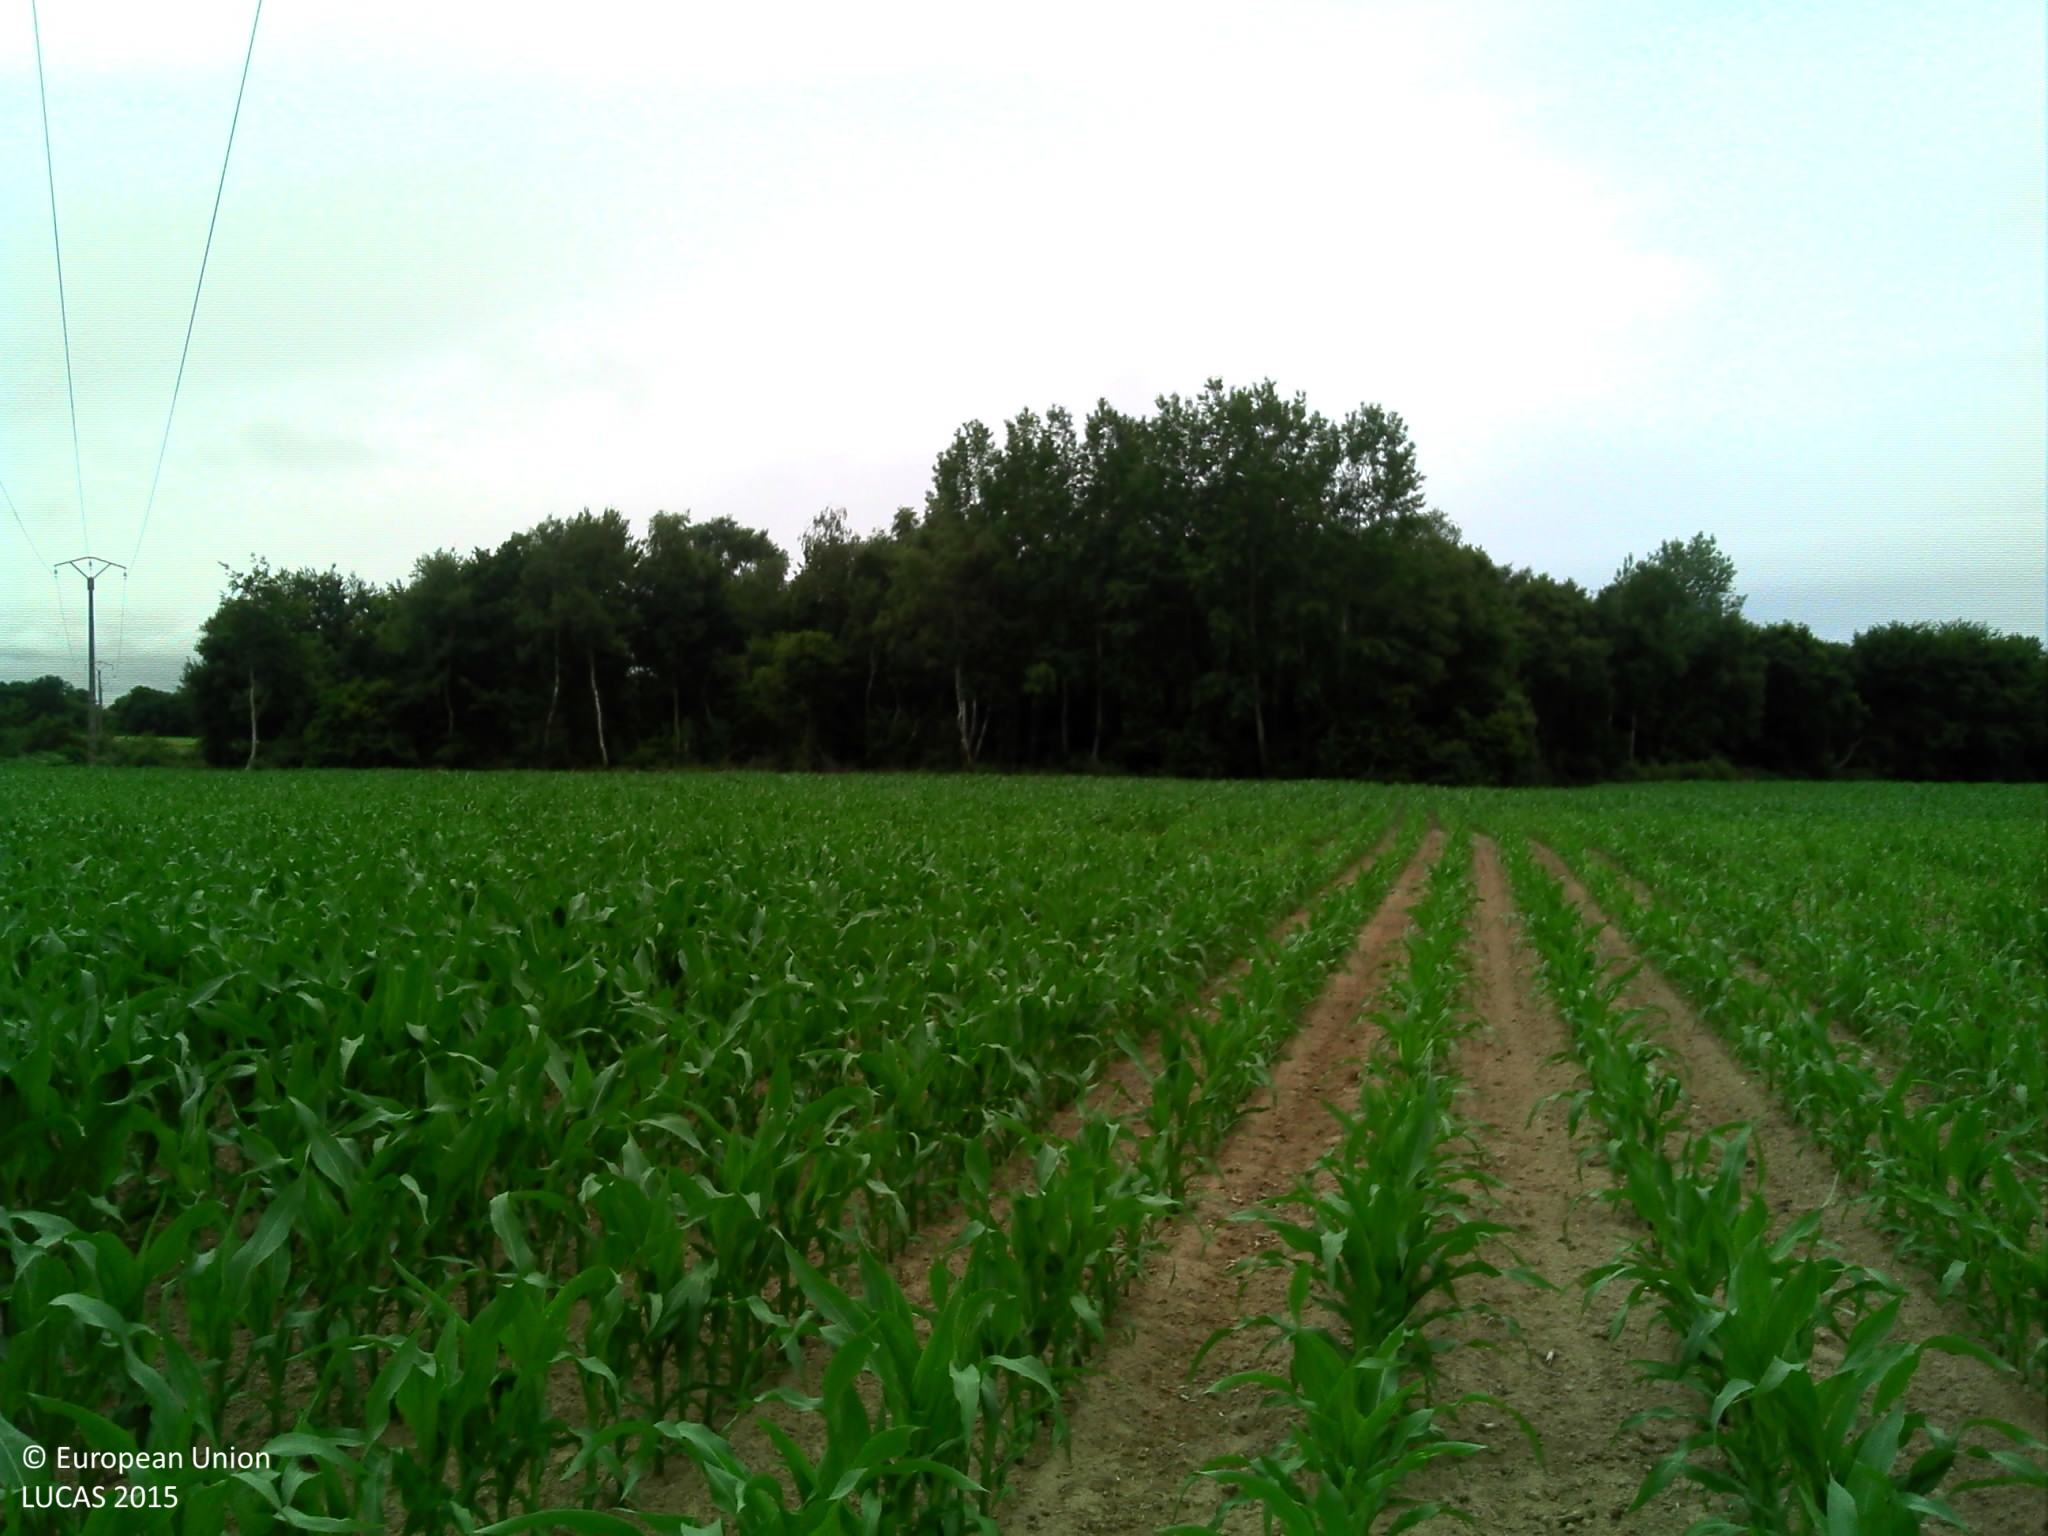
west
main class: Cropland
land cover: Maize
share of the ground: 50 - 75 %
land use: Agriculture (excluding fallow land and kitchen gardens)
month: July
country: FR
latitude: 48.6610
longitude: -3.5348
